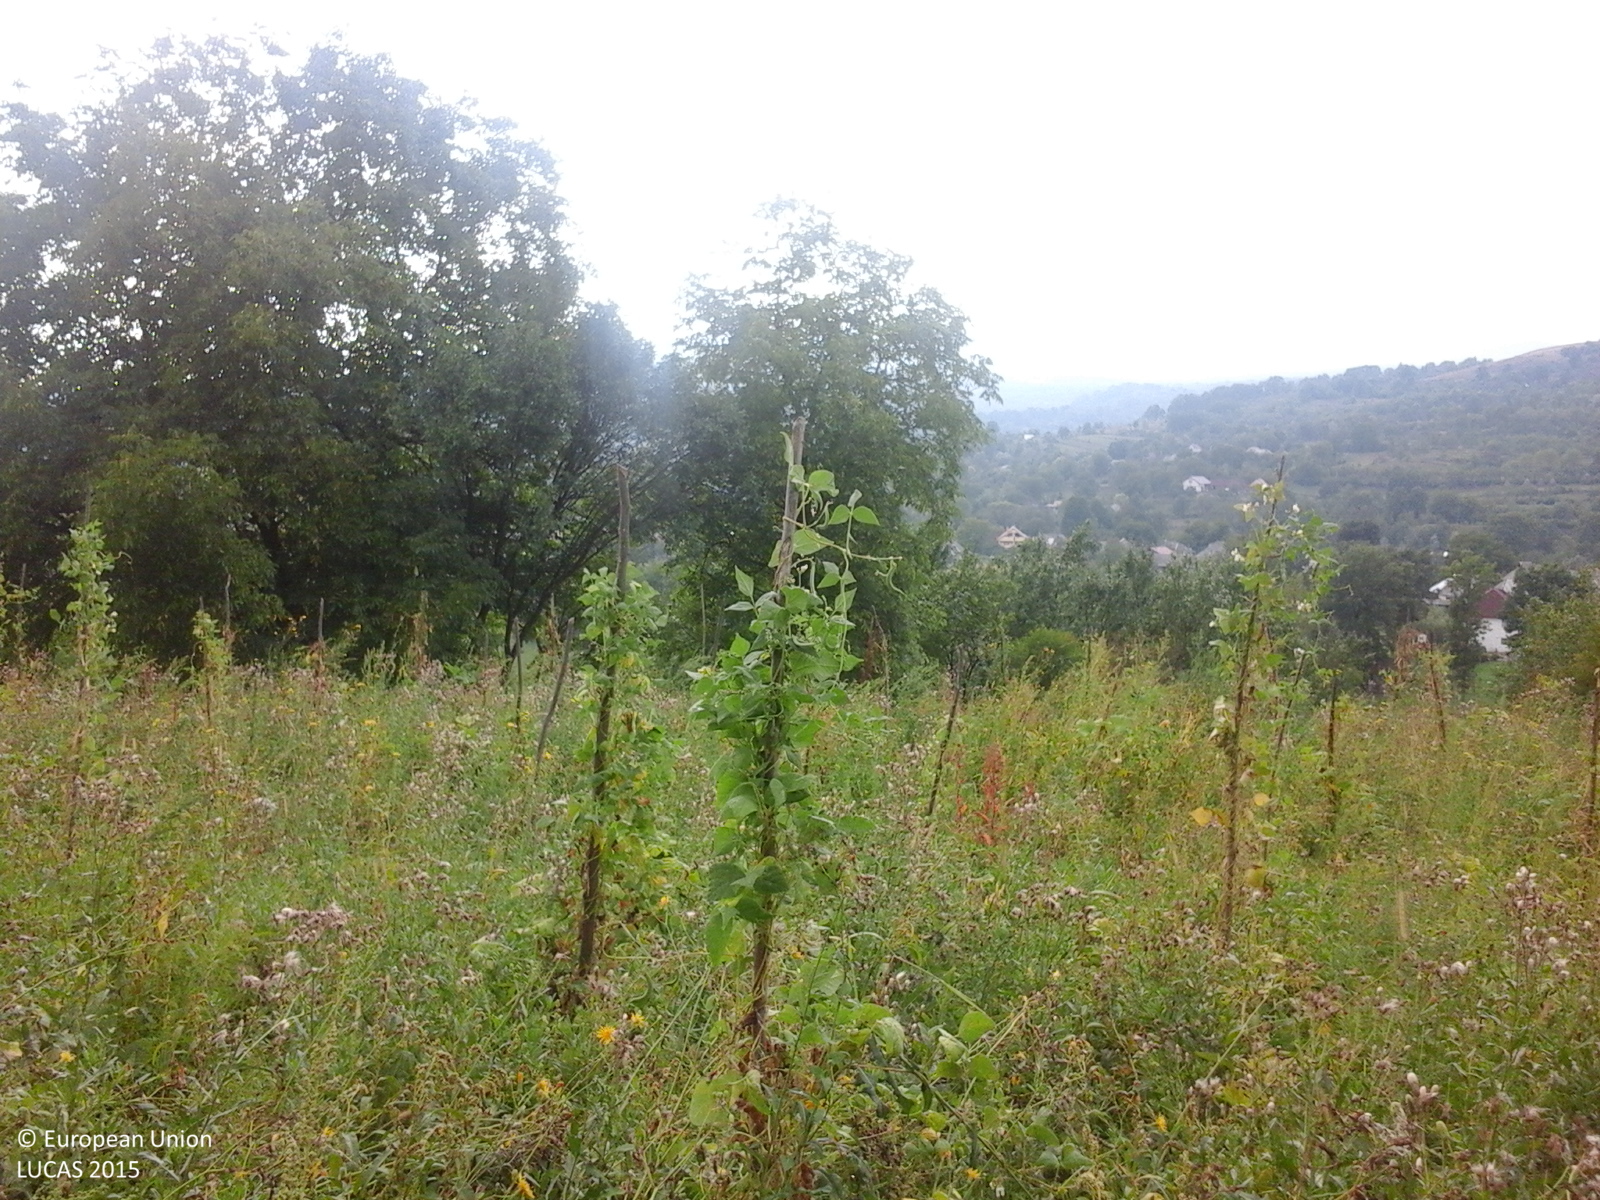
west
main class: Cropland
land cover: Other fresh vegetables
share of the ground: 50 - 75 %
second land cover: Spontaneously vegetated surfaces
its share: 25 - 50 %
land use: Agriculture (excluding fallow land and kitchen gardens)
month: September
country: RO
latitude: 47.8259
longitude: 23.9360
